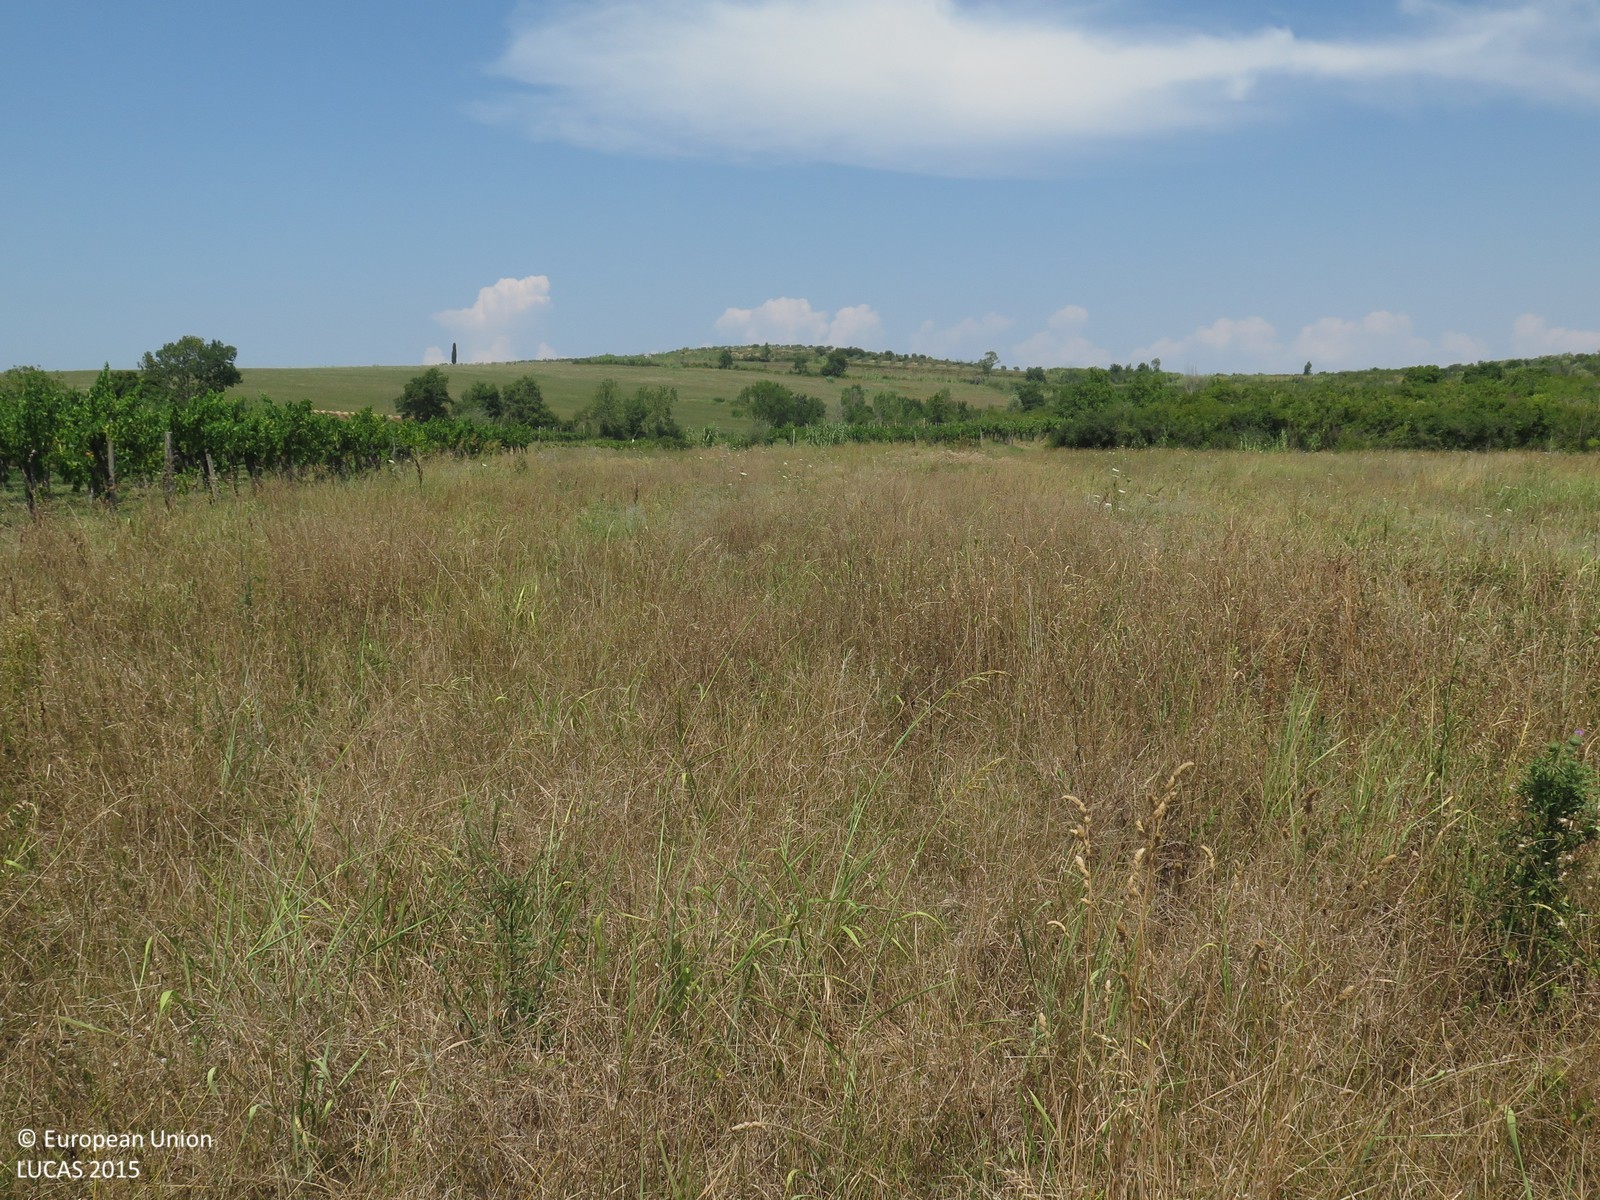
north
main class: Grassland
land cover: Spontaneously vegetated surfaces
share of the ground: > 75 %
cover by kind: herbaceous plants 95 %, shrubs 5 %
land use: Fallow land
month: July
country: HR
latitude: 45.4057
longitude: 13.6365
